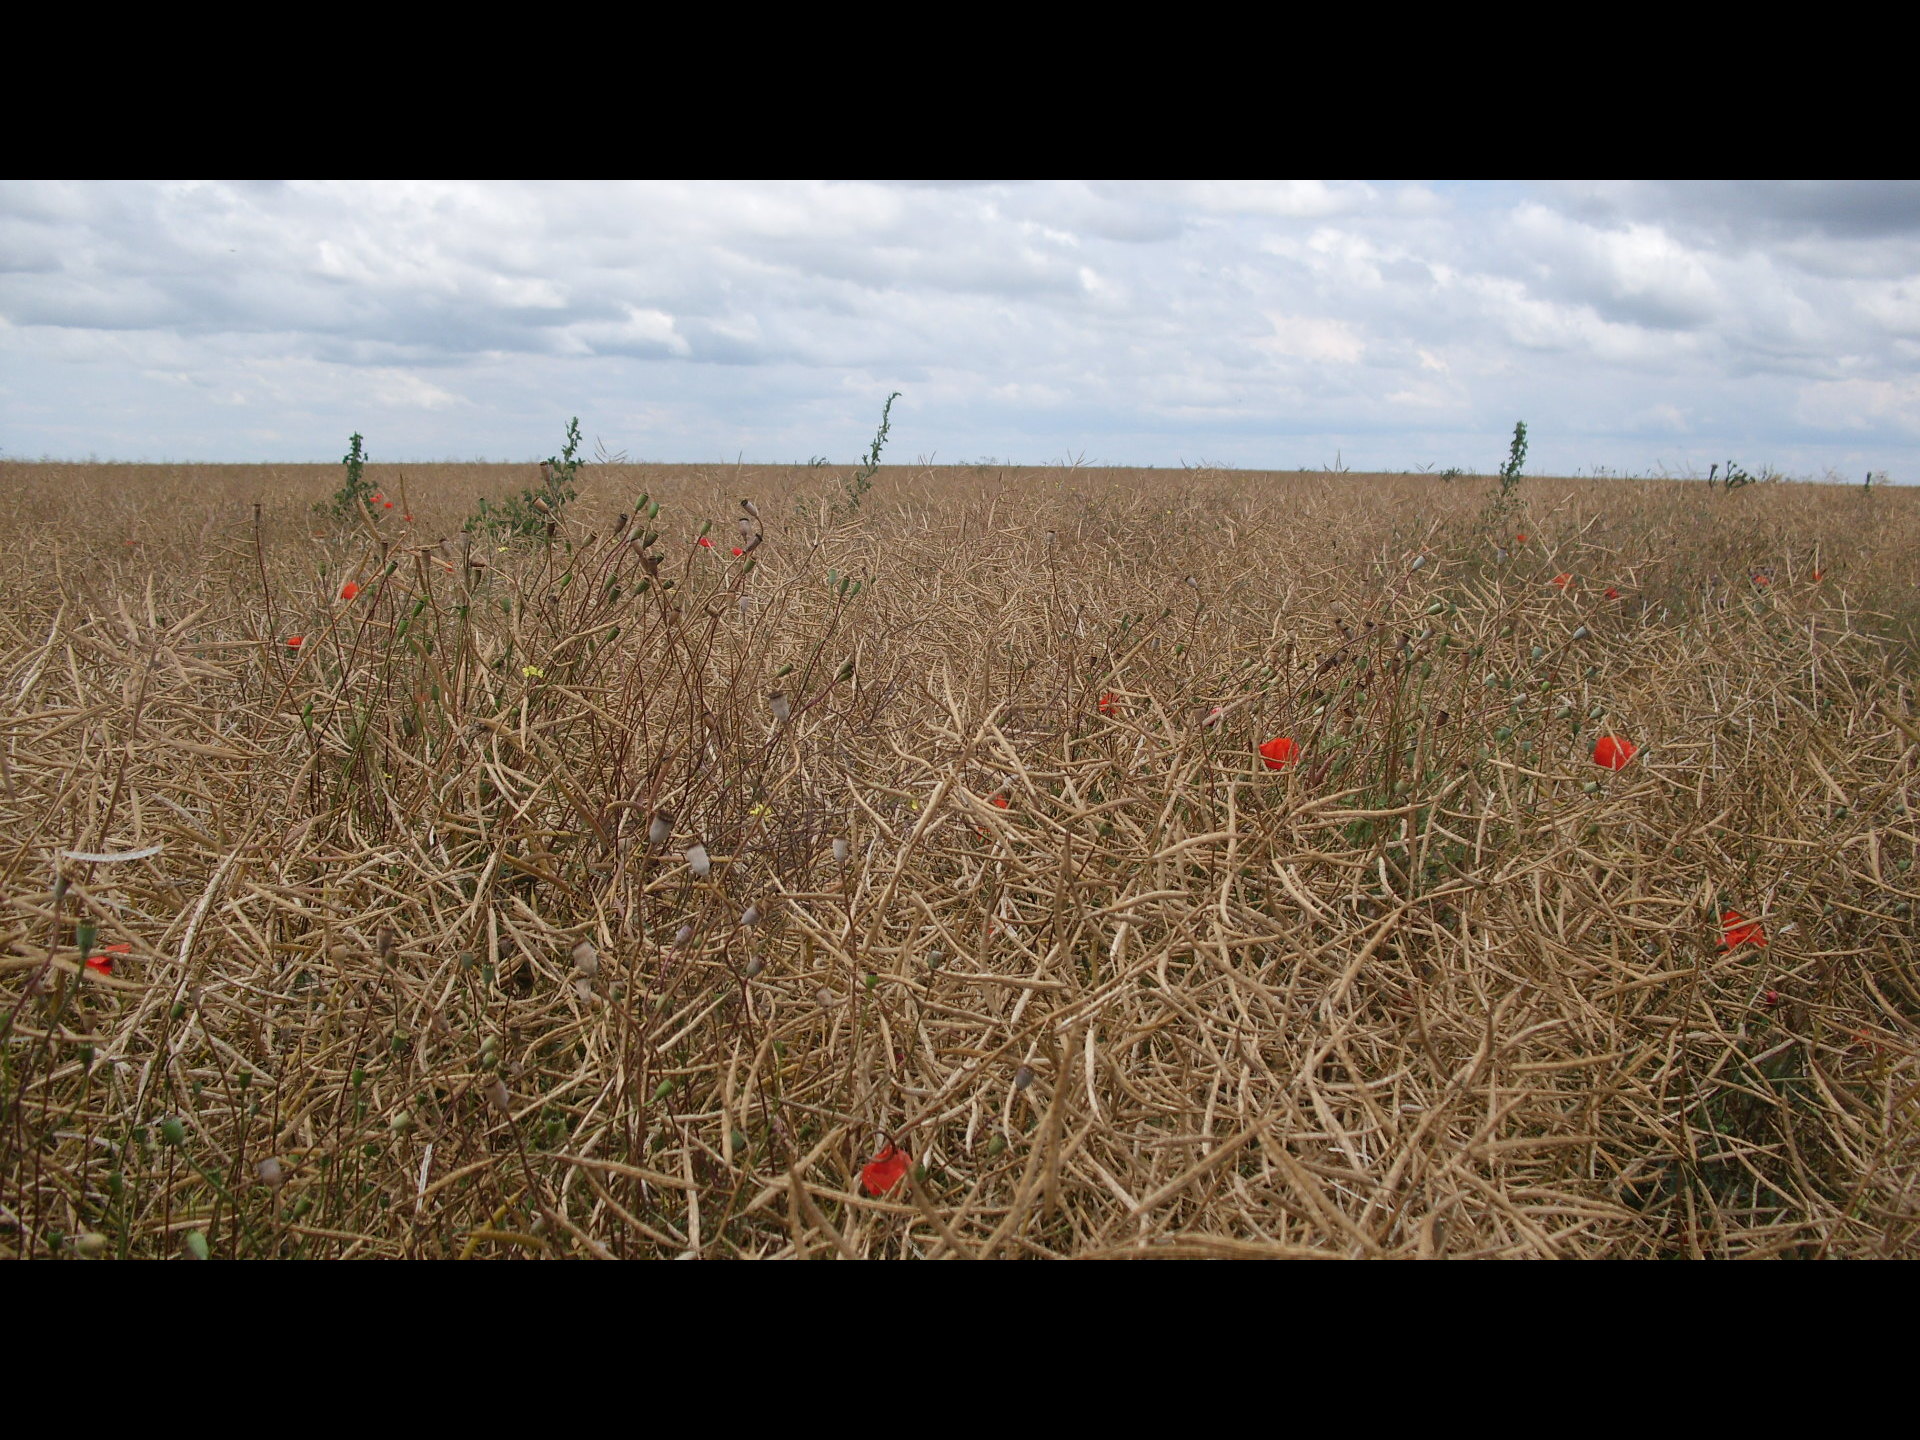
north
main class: Cropland
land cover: Rape and turnip rape
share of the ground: > 75 %
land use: Agriculture (excluding fallow land and kitchen gardens)
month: June
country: BG
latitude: 43.6371
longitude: 23.5705
